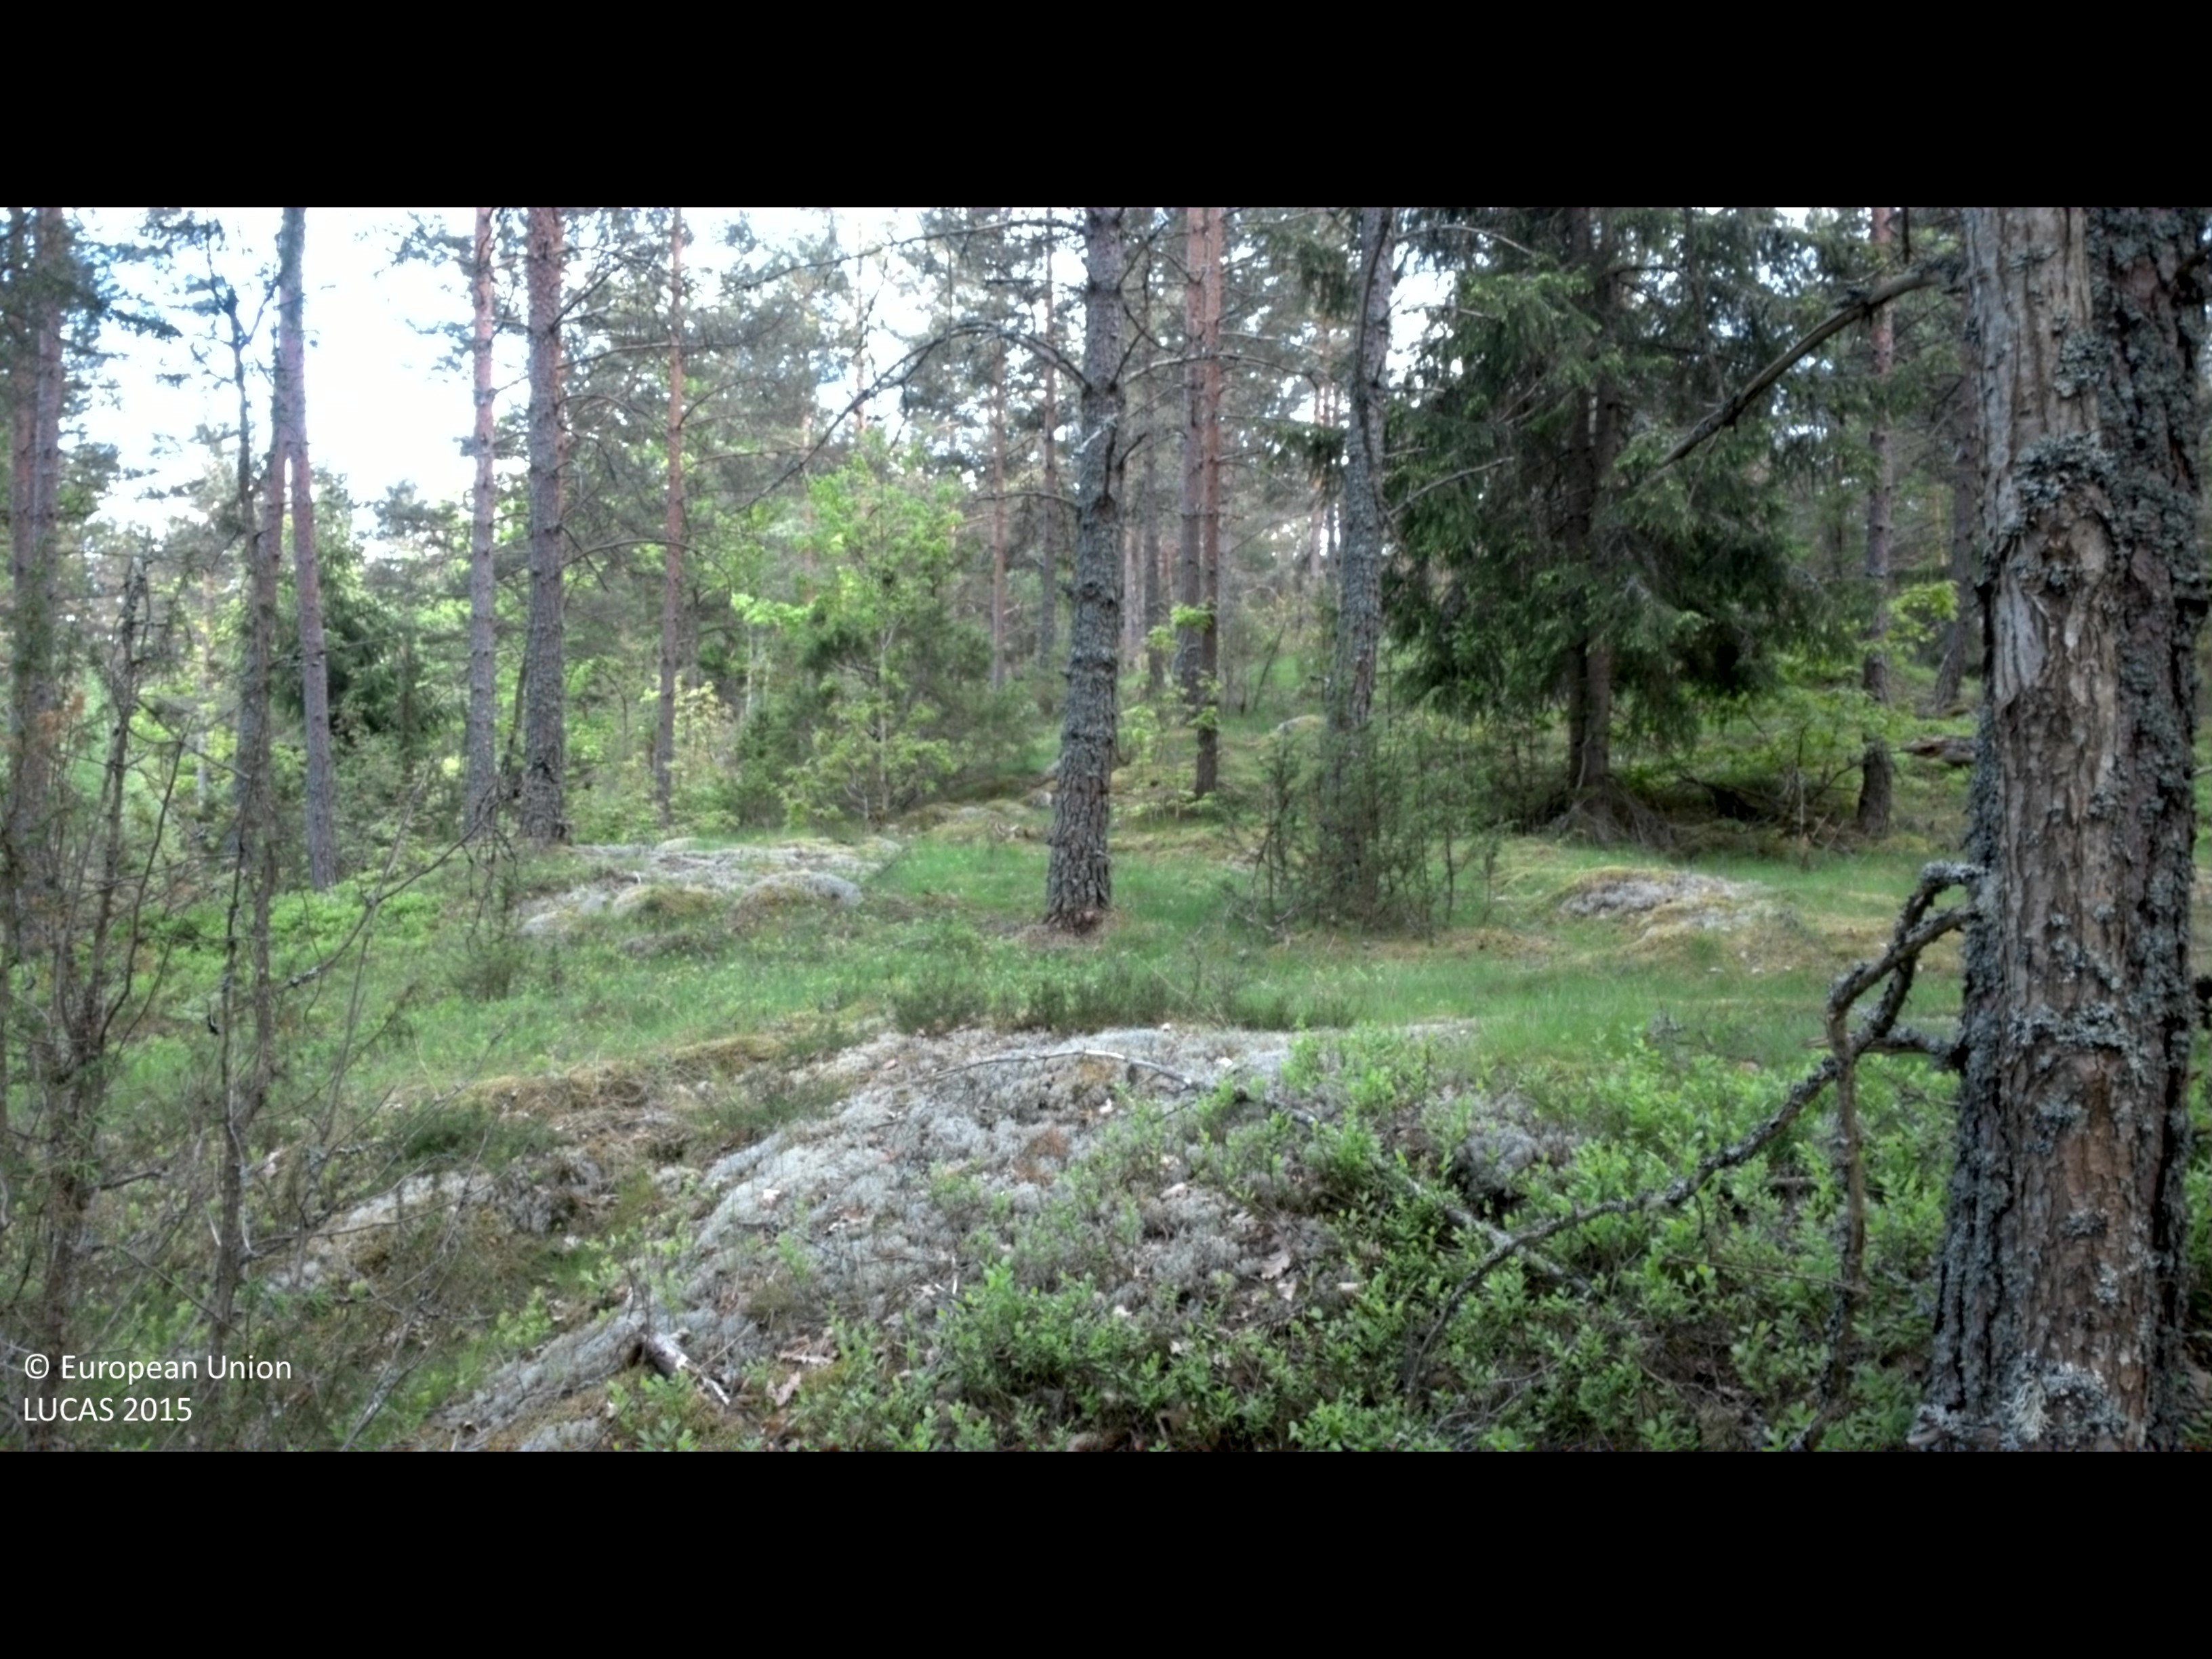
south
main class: Woodland
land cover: Pine dominated coniferous woodland
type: boreal forest
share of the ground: 50 - 75 %
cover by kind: coniferous forest trees 65 %, shrubs 15 %, lichens and mosses 10 %, broadleaved forest trees 5 %, herbaceous plants 5 %
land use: Forestry
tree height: > 5 m
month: May
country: SE
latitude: 57.4494
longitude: 16.4816
